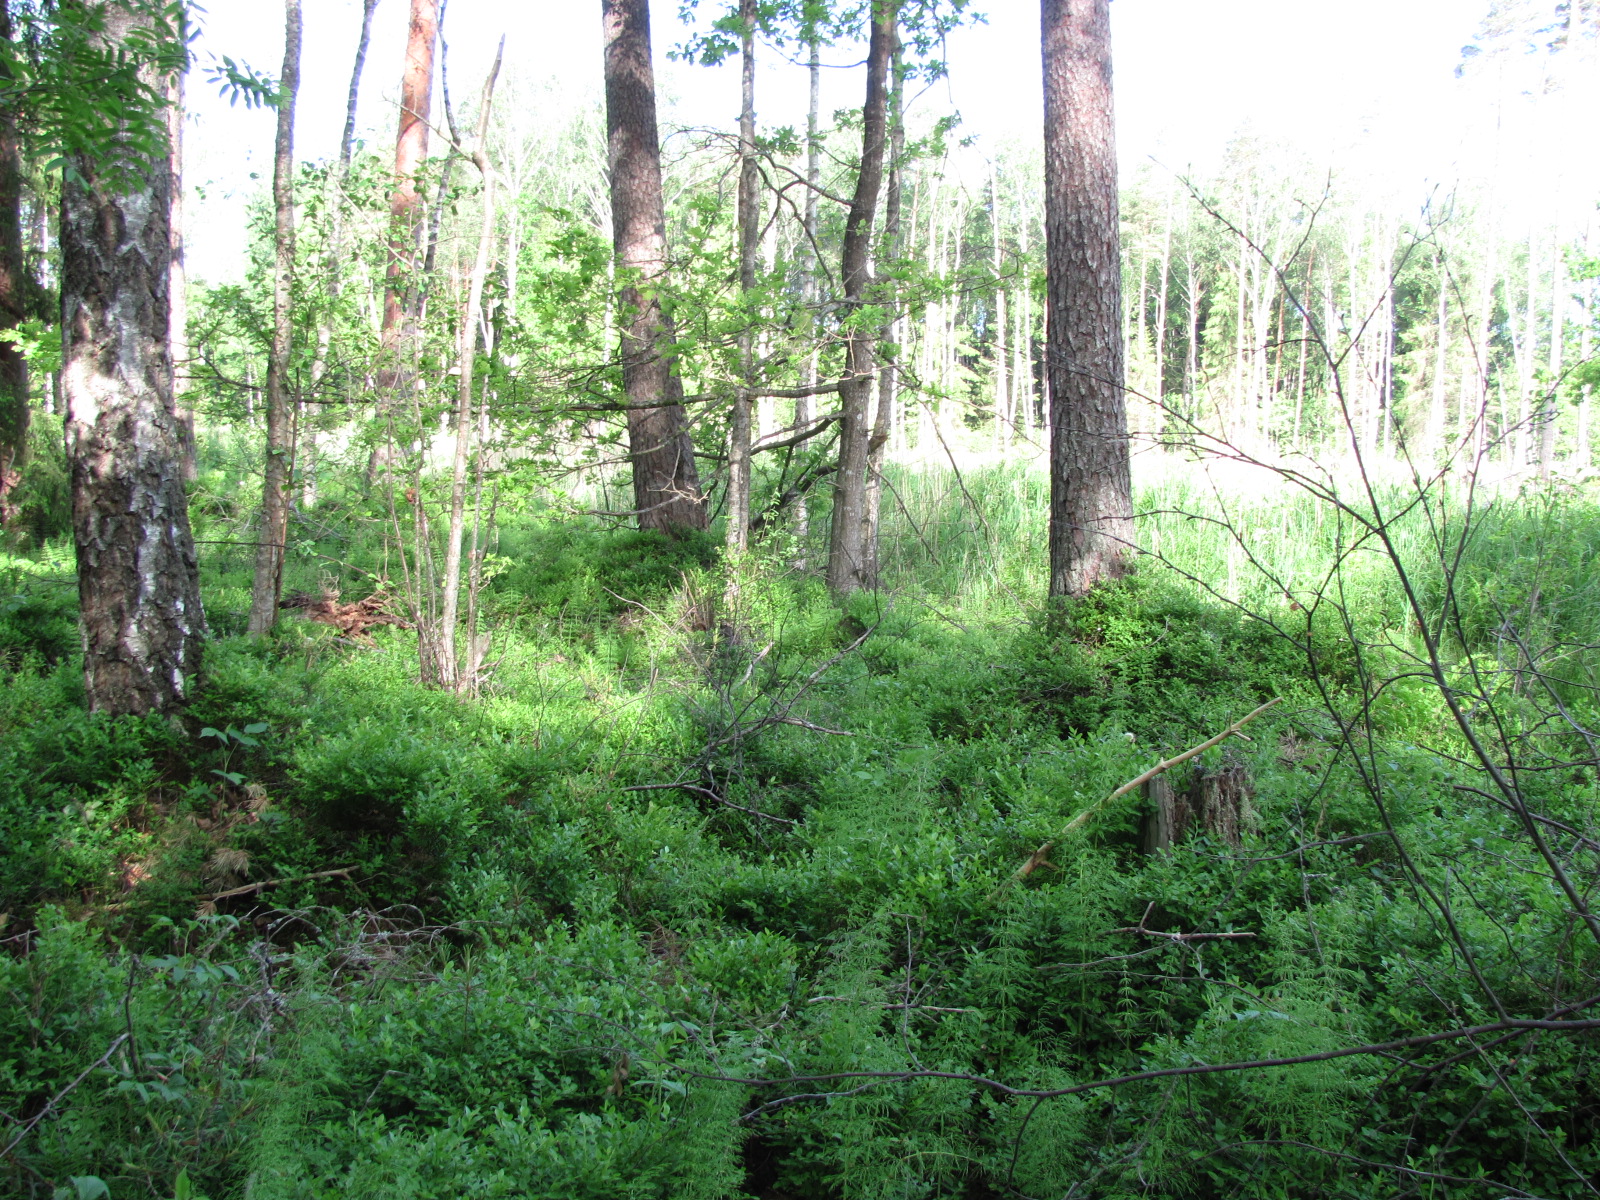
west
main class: Woodland
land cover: Other mixed woodland
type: hemiboreal forest and nemoral coniferous forest and mixed broadleaved-coniferous forest
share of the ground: > 75 %
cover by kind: broadleaved forest trees 45 %, coniferous forest trees 40 %, herbaceous plants 15 %
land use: Forestry
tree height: > 5 m
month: June
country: LV
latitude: 56.7357
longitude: 23.9618
